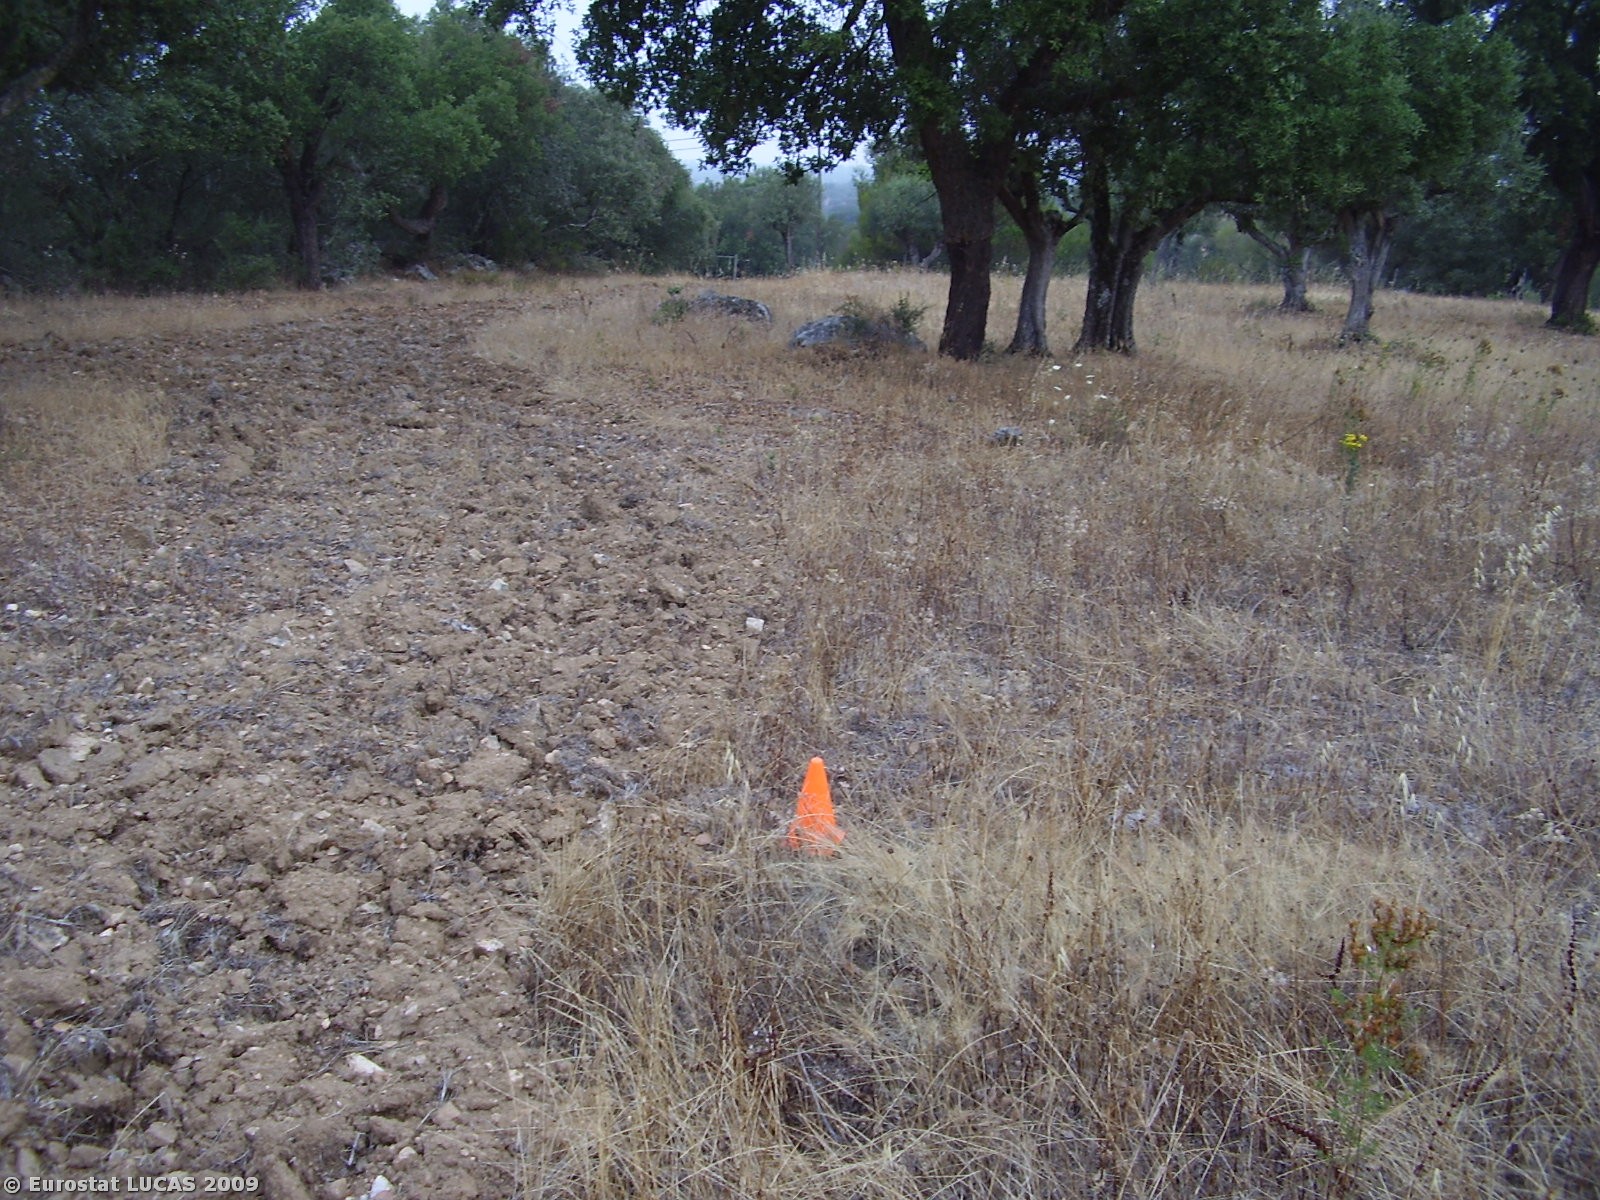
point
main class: Cropland
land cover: Olive groves
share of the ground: 10 - 25 %
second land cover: Spontaneously vegetated surfaces
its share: 50 - 75 %
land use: Agriculture (excluding fallow land and kitchen gardens)
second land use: Fallow land
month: July
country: PT
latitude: 38.8168
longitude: -7.8598
